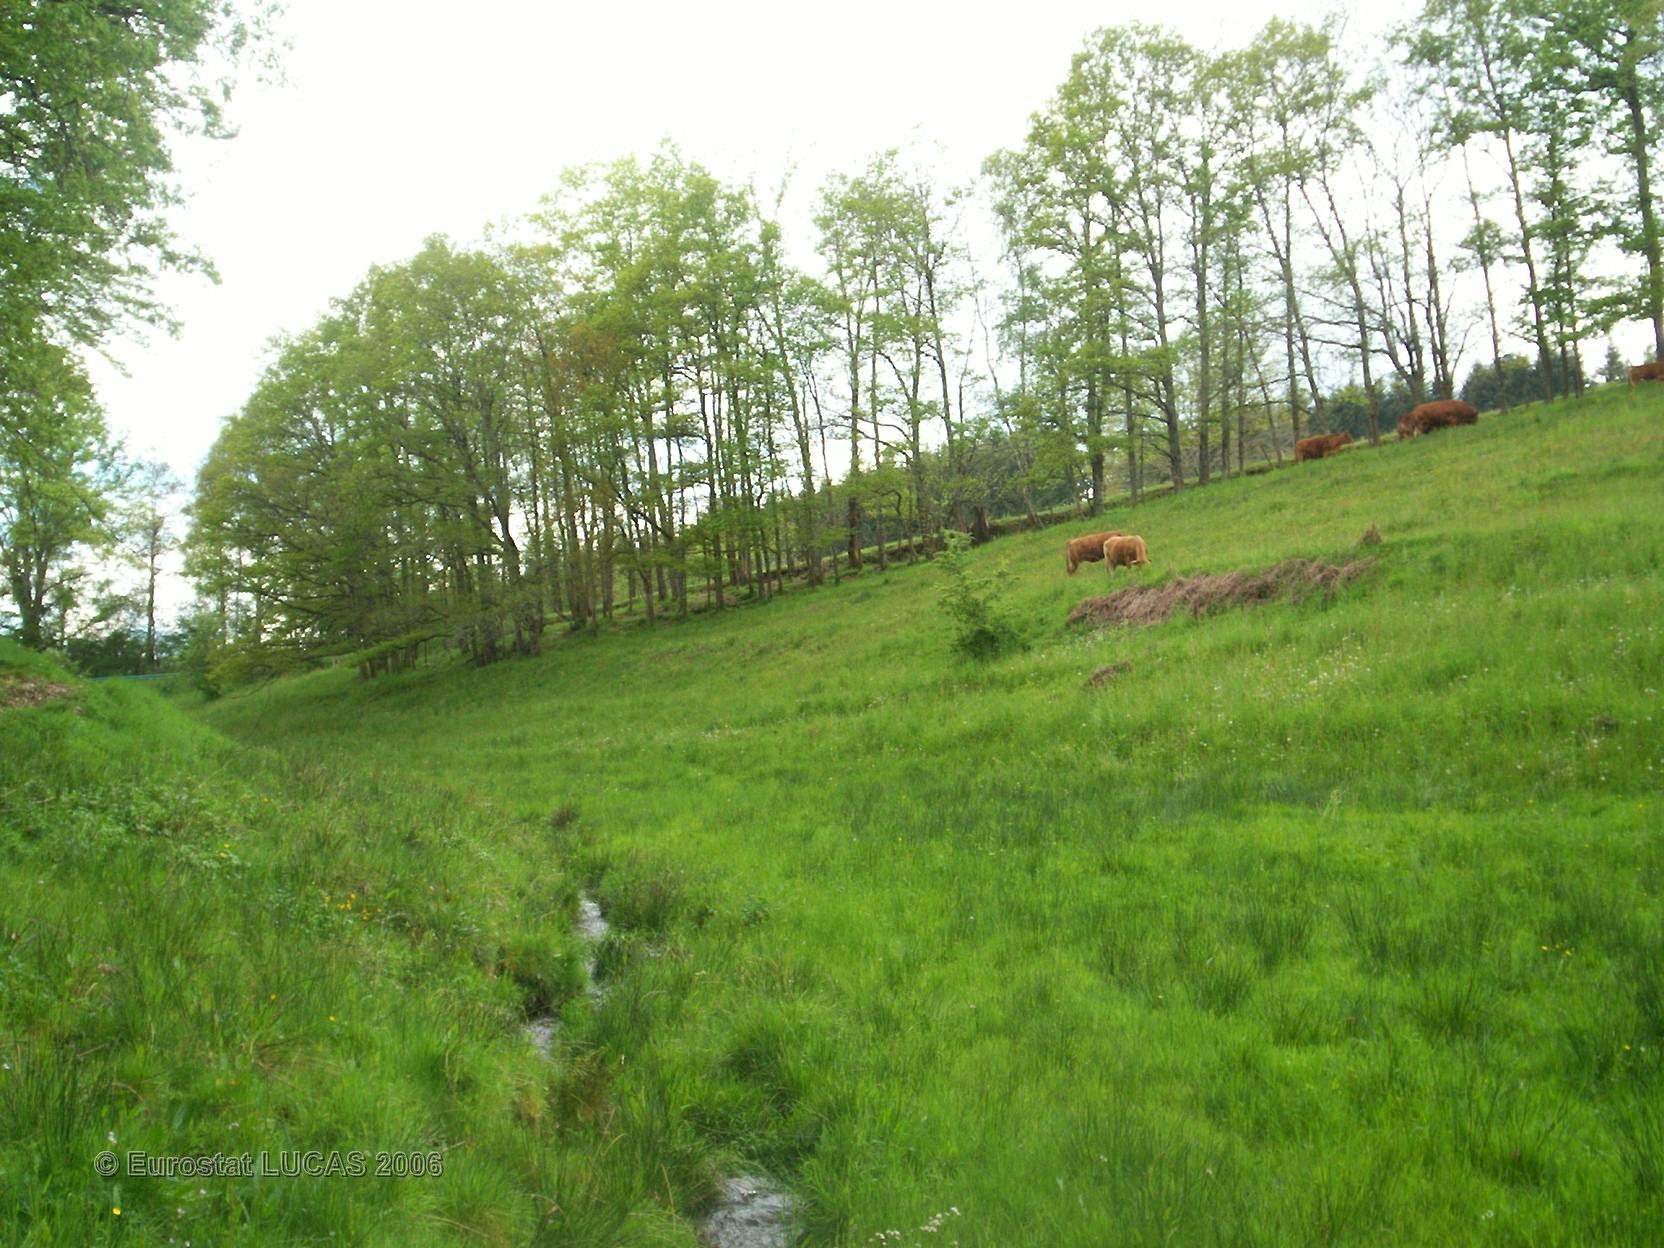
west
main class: Grassland
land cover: Grassland without tree/shrub cover
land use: Agriculture (excluding fallow land and kitchen gardens)
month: May
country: FR
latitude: 45.7288
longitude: 1.5765
